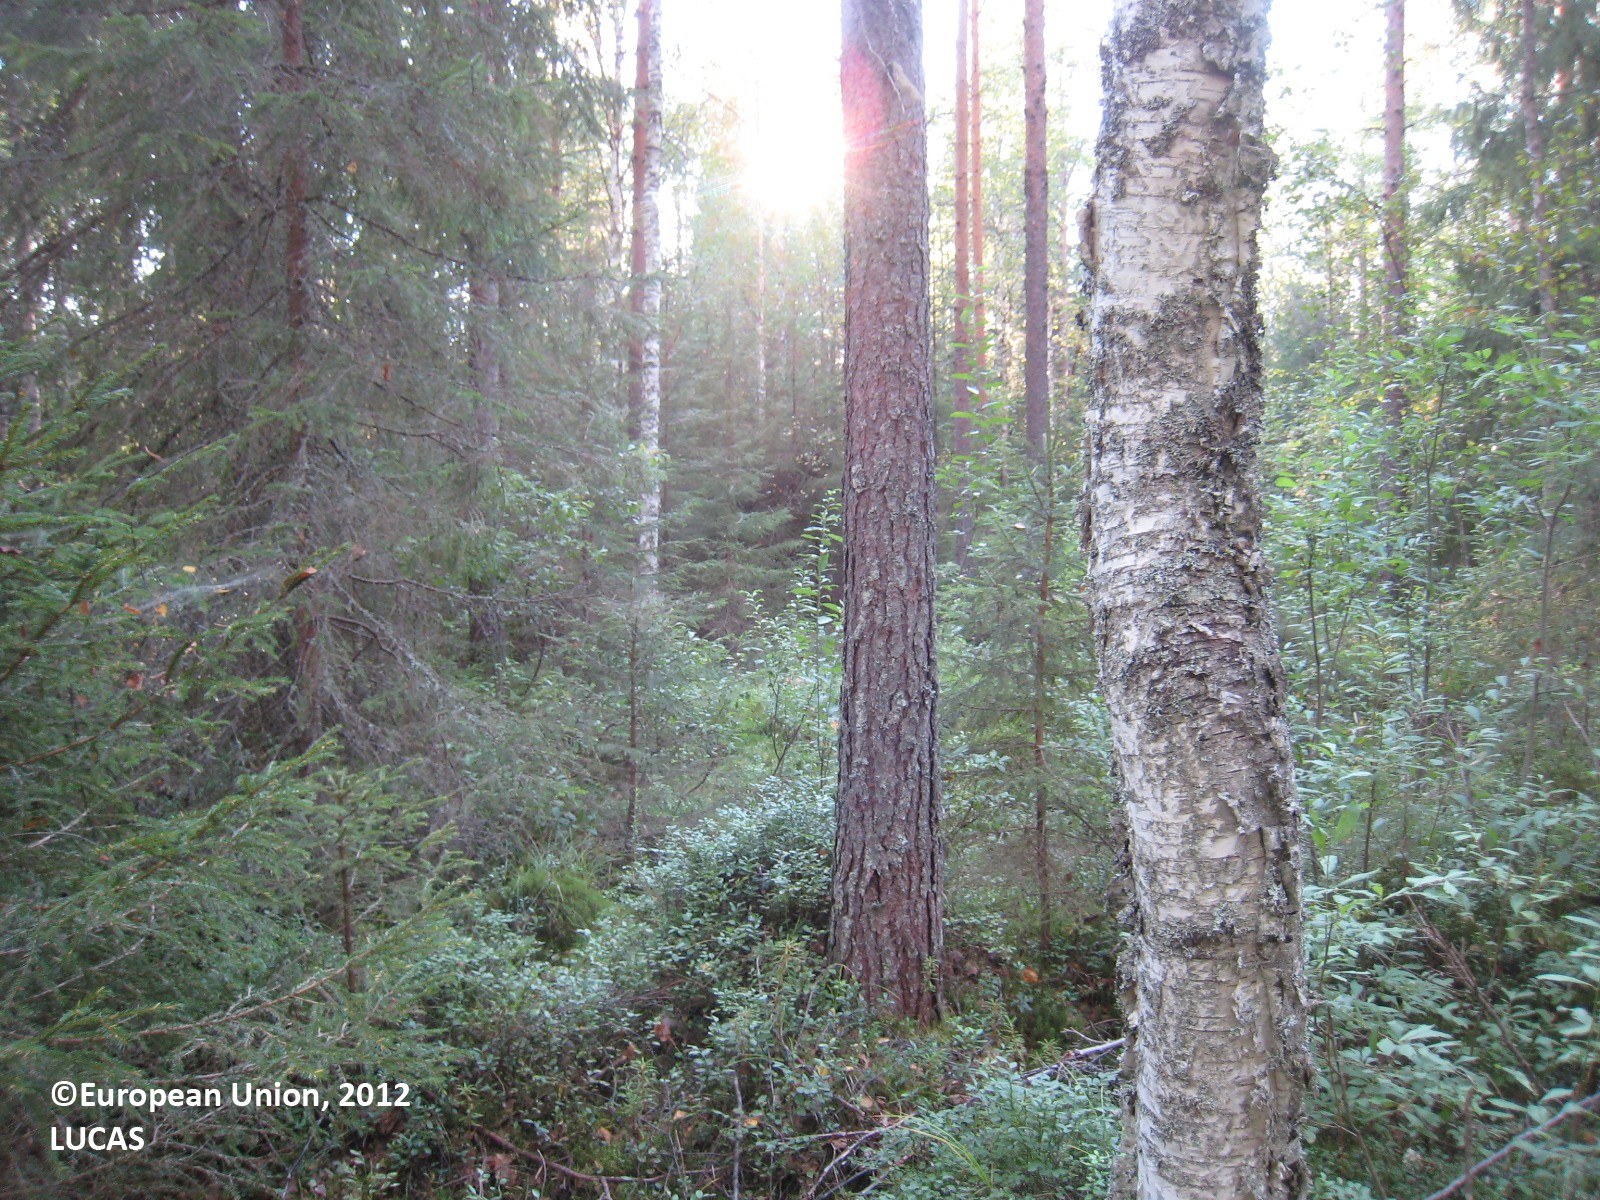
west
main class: Woodland
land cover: Other mixed woodland
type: boreal forest
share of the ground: > 75 %
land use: Forestry
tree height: > 5 m
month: August
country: FI
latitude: 62.1024
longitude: 27.2725
